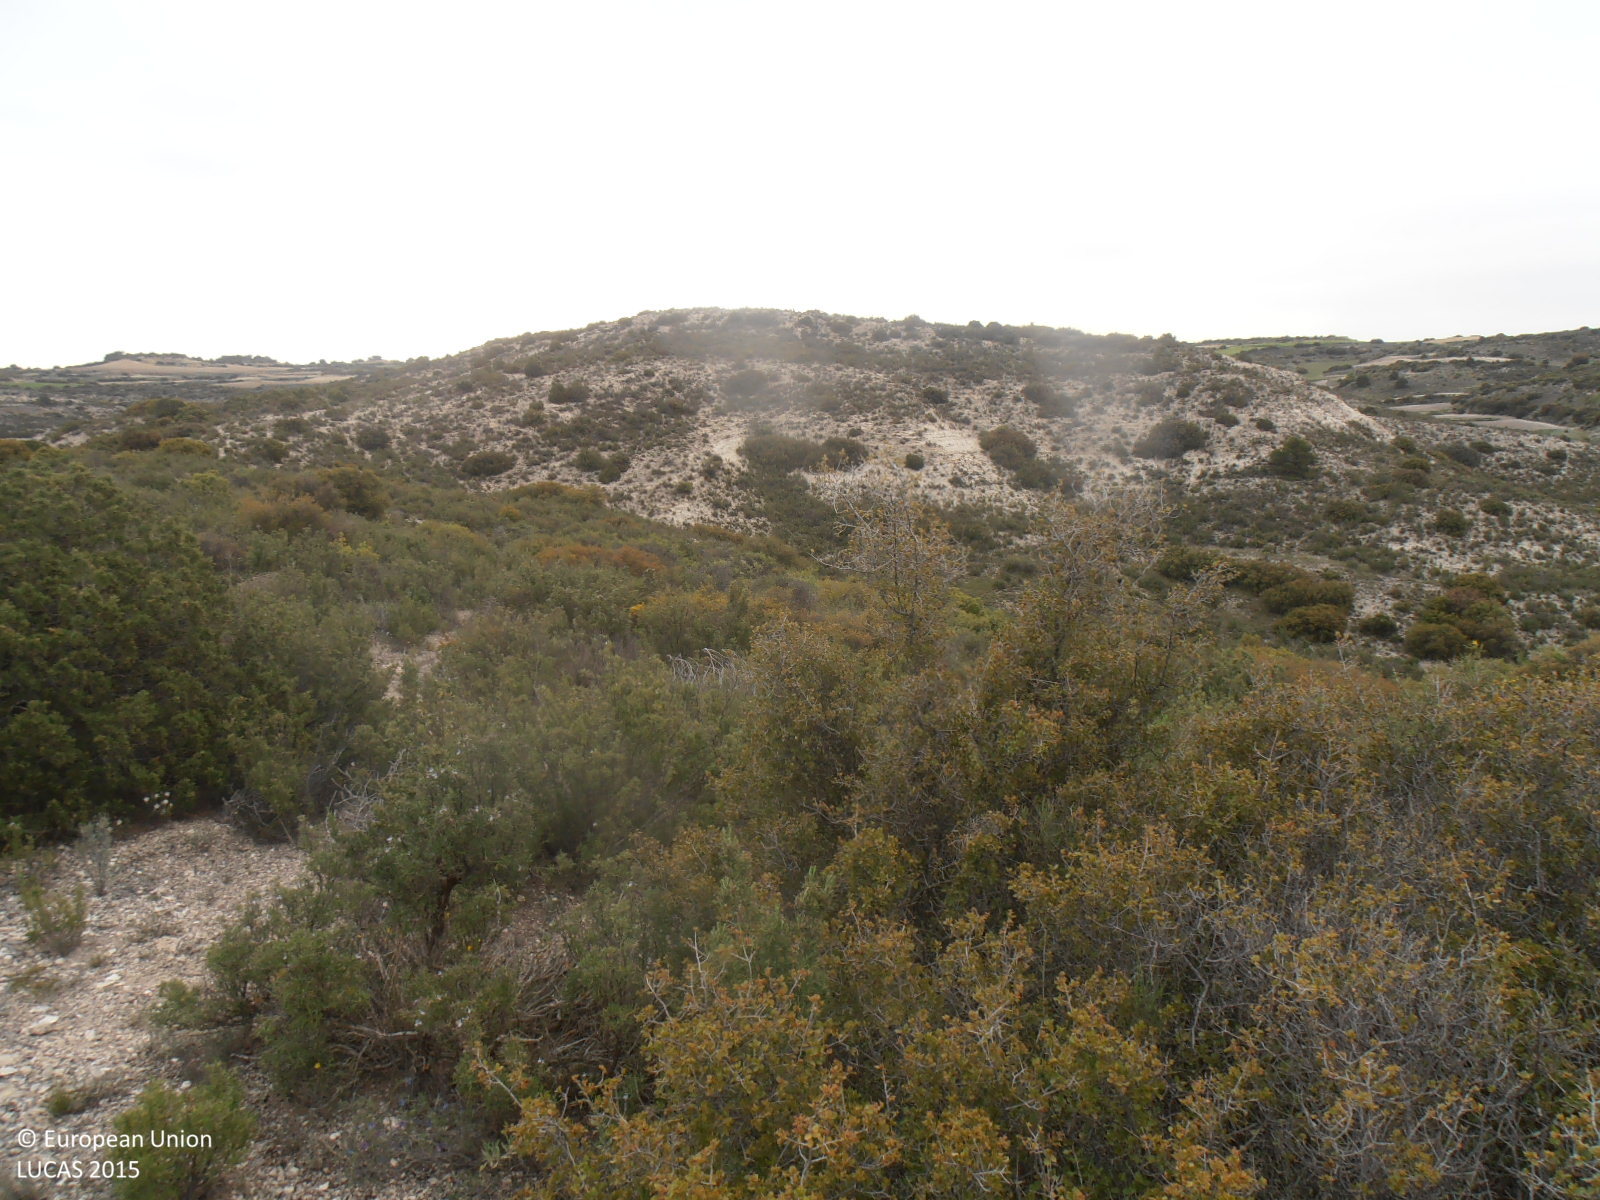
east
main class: Shrubland
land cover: Shrubland without tree cover
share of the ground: > 75 %
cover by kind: shrubs 75 %, consolidated bare surface 25 %
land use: Semi-natural and natural areas not in use
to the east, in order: Shrubland without tree cover; Shrubland with sparse tree cover
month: May
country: ES
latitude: 41.4217
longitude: -0.9442
